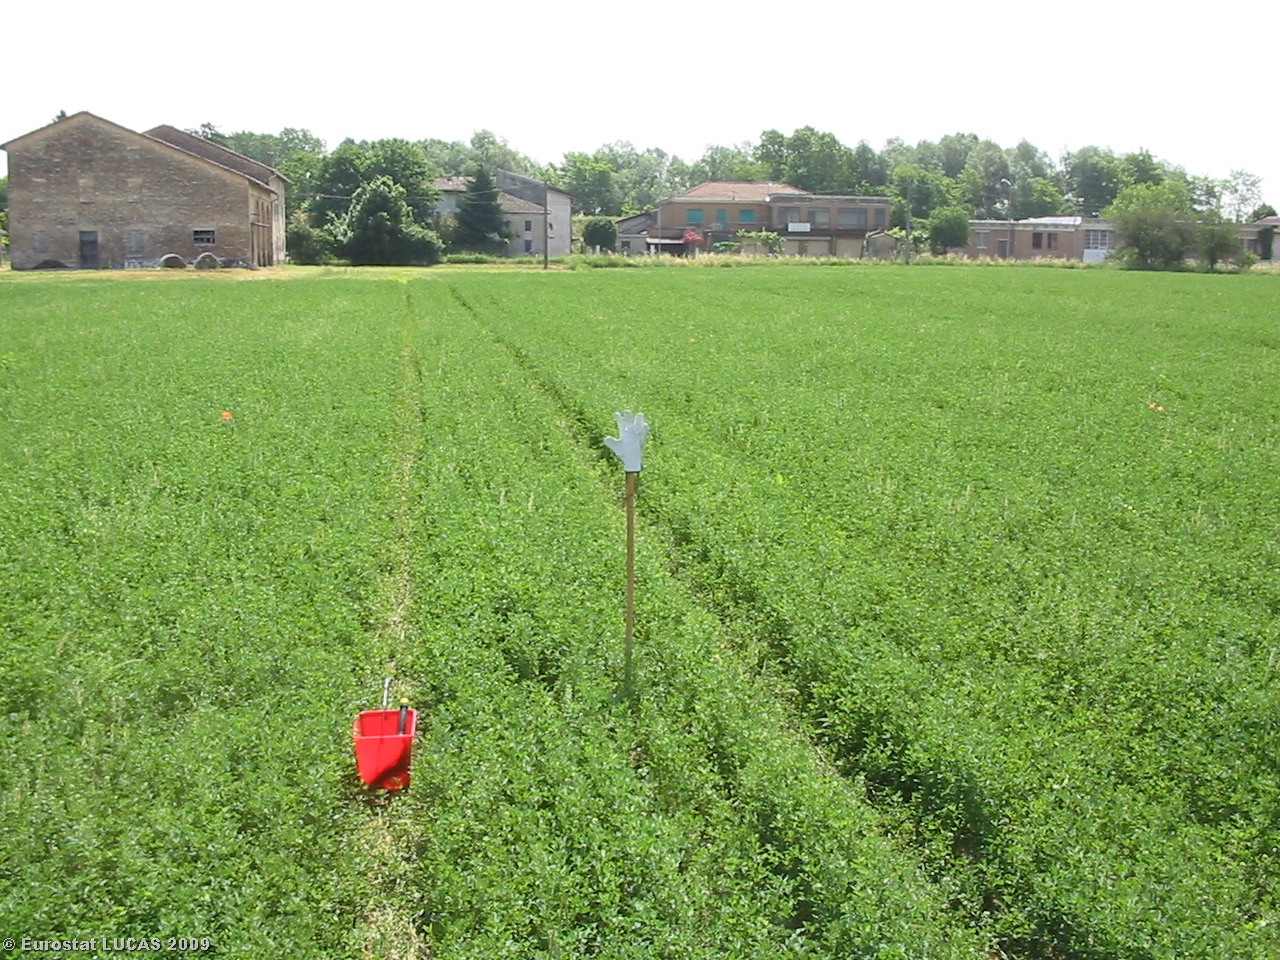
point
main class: Cropland
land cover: Lucerne
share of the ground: > 75 %
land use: Agriculture (excluding fallow land and kitchen gardens)
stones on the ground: < 10 %
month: May
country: IT
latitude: 44.9091
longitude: 10.3160
